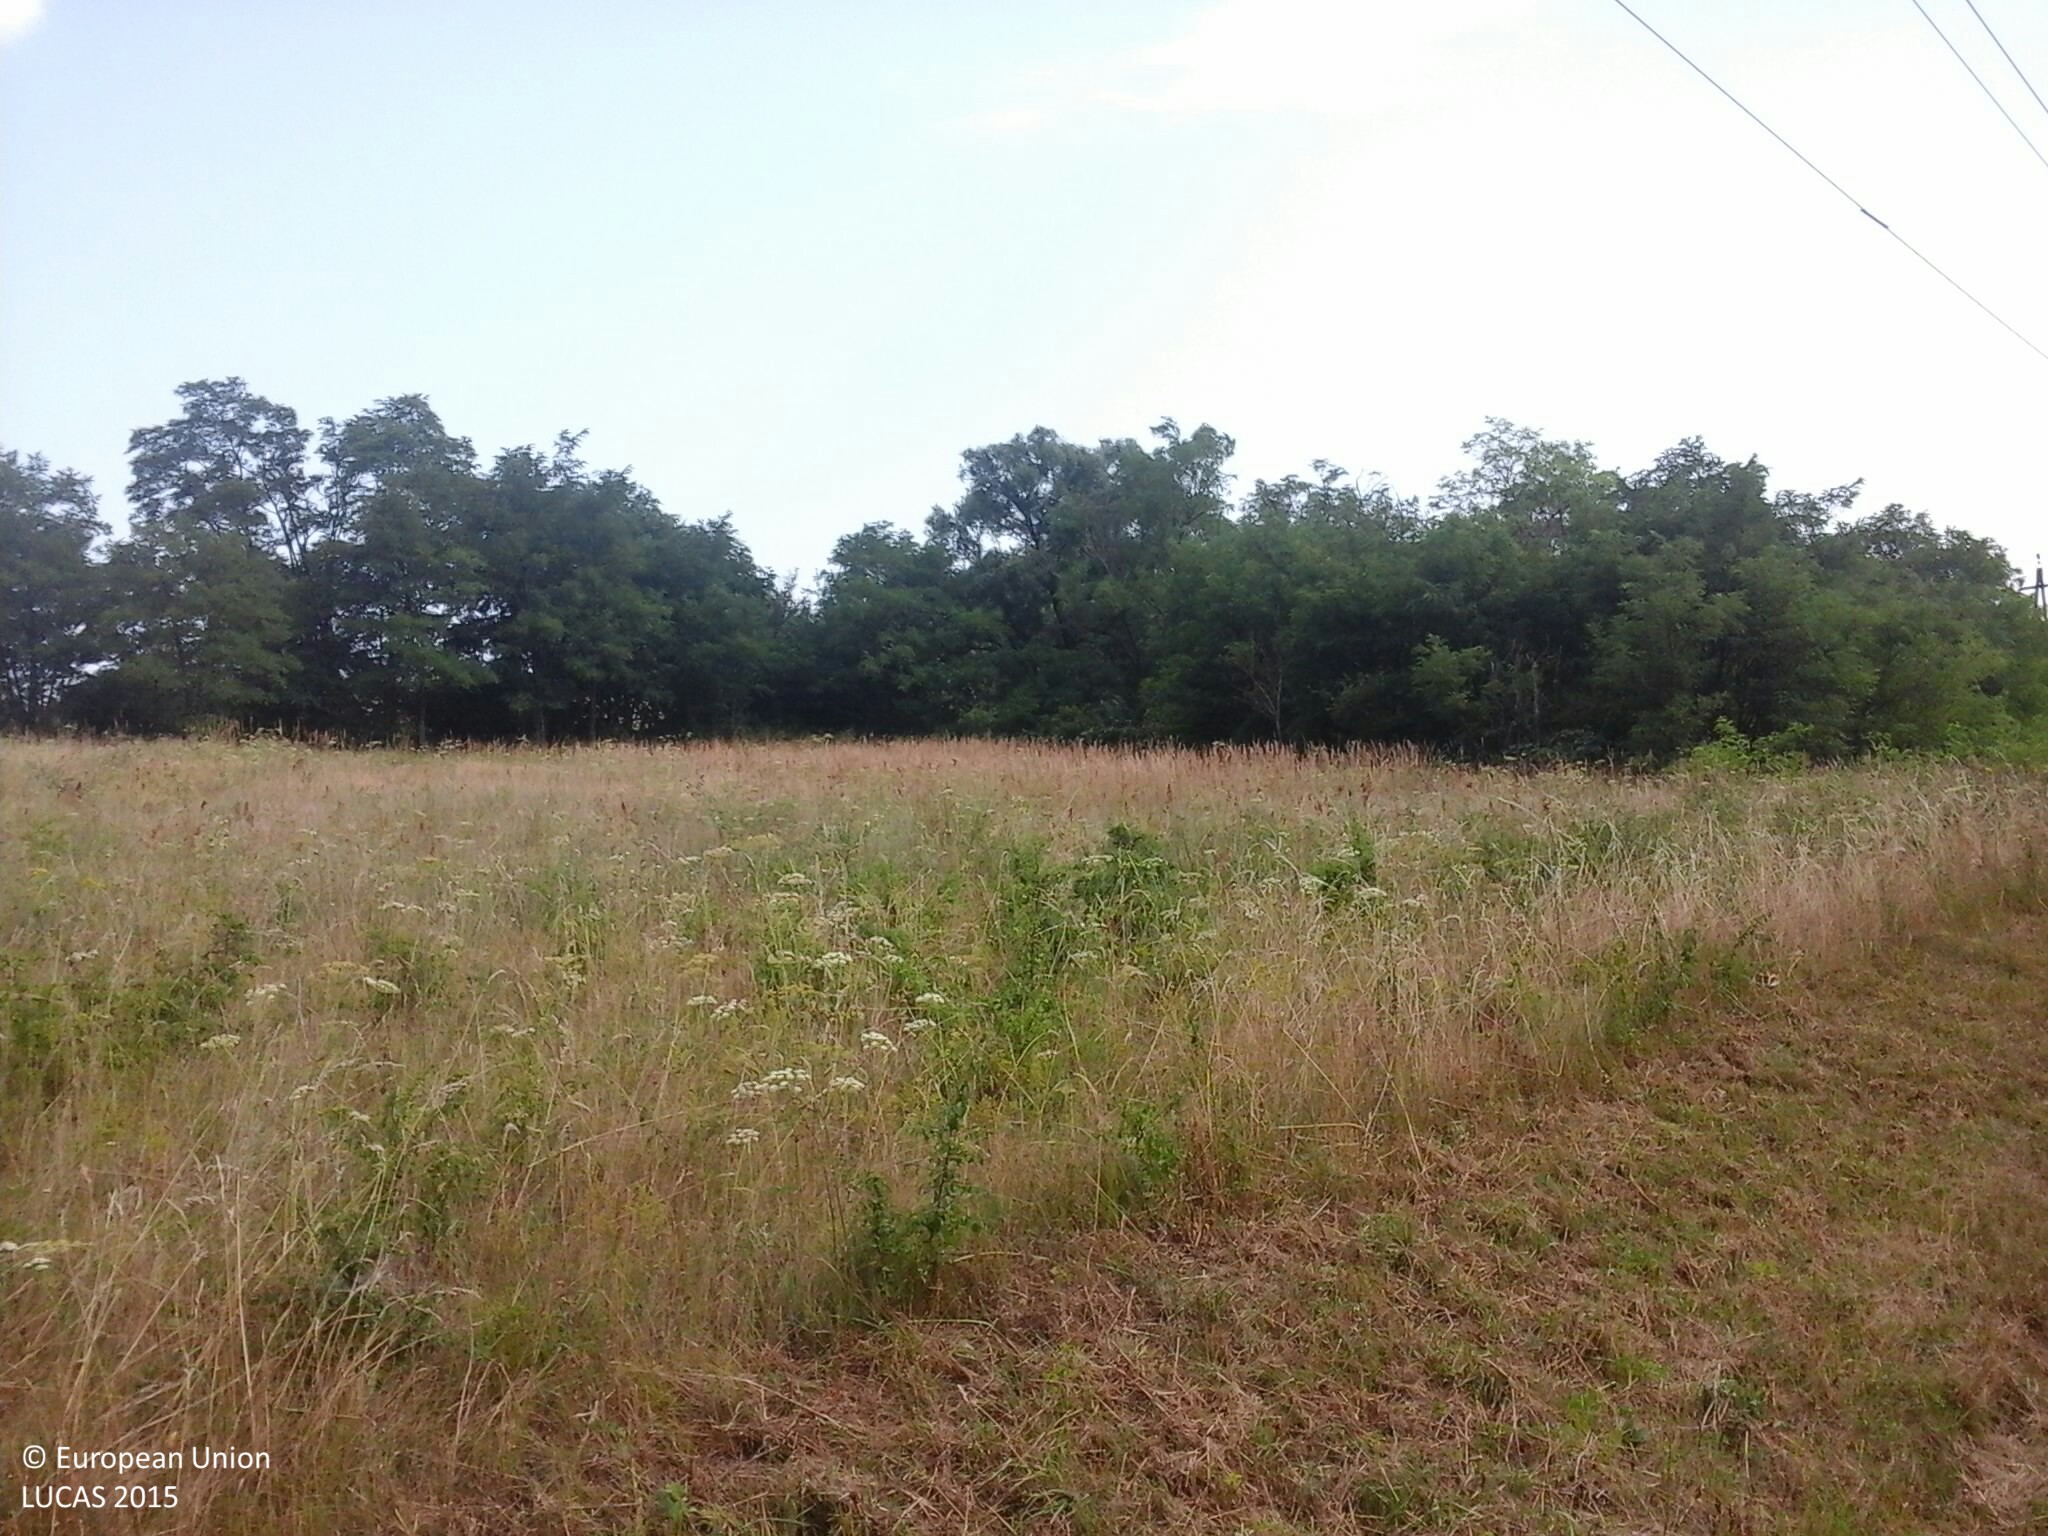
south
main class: Grassland
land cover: Grassland without tree/shrub cover
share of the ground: > 75 %
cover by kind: herbaceous plants 100 %
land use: Community services
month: July
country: HU
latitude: 46.9586
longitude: 17.4572
